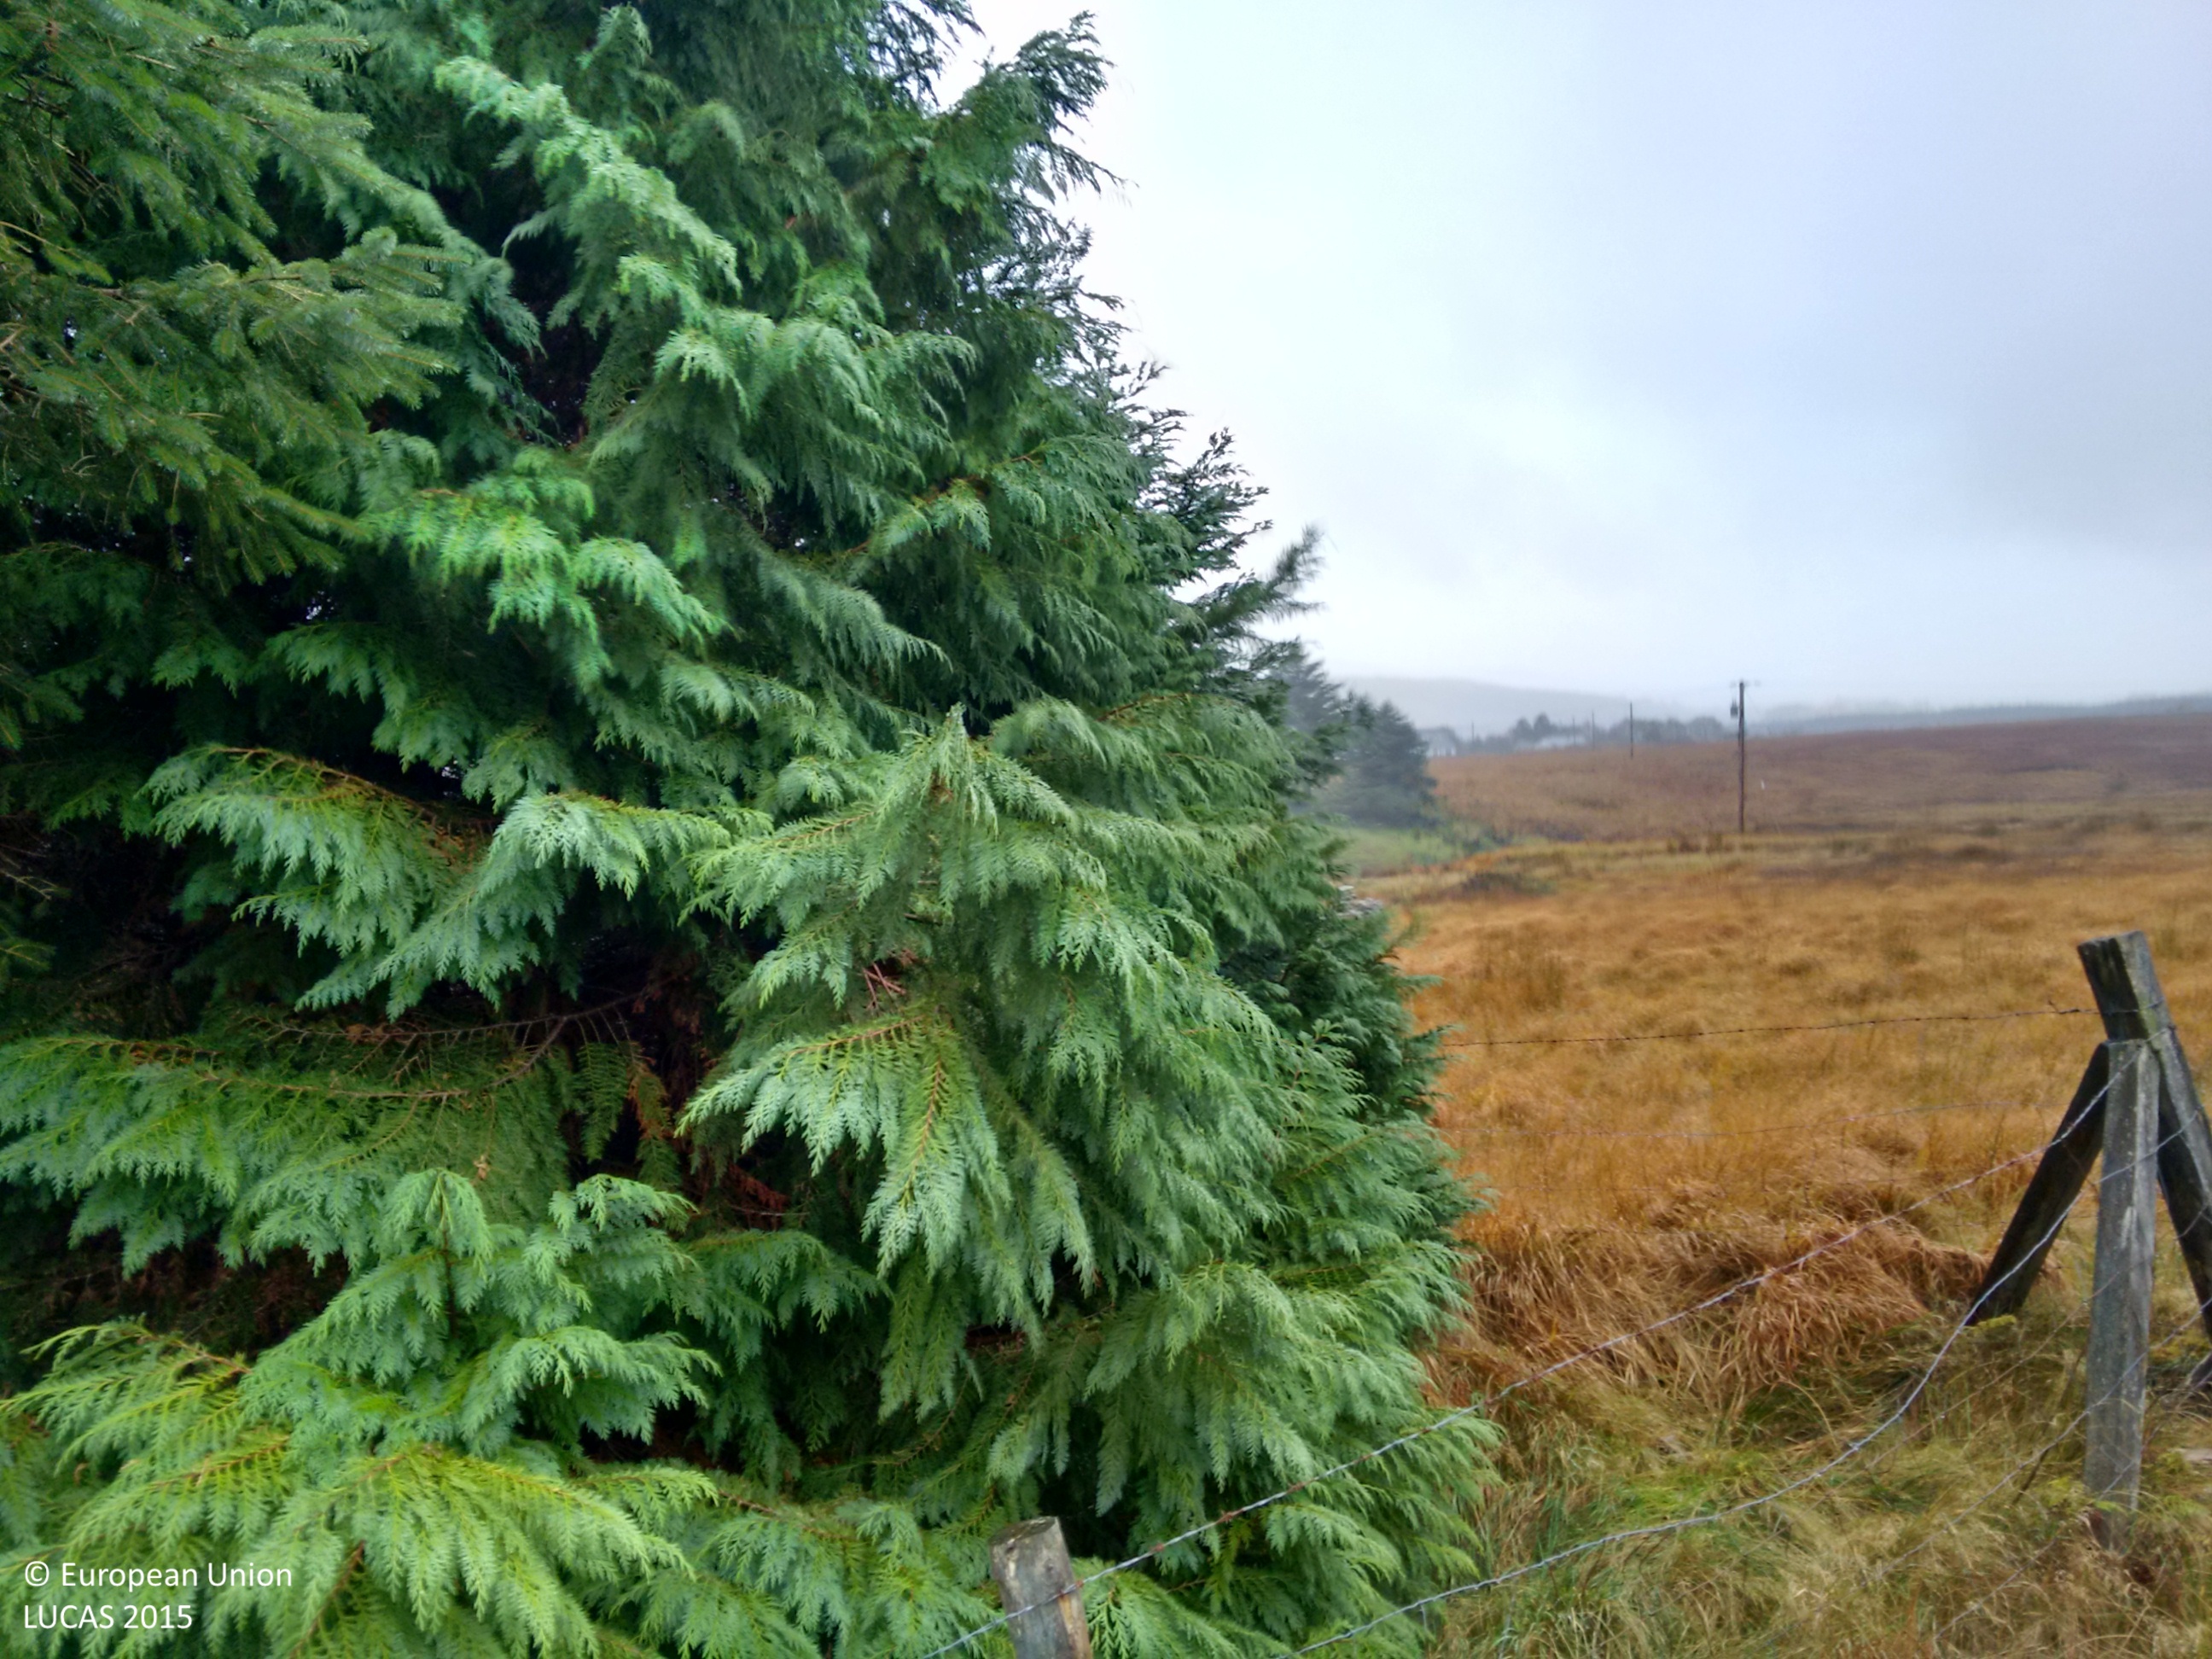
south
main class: Woodland
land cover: Spruce dominated coniferous woodland
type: exotic forest
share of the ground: > 75 %
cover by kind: coniferous forest trees 90 %, herbaceous plants 10 %
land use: Forestry
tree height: > 5 m
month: November
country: IE
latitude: 54.8239
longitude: -8.2517
